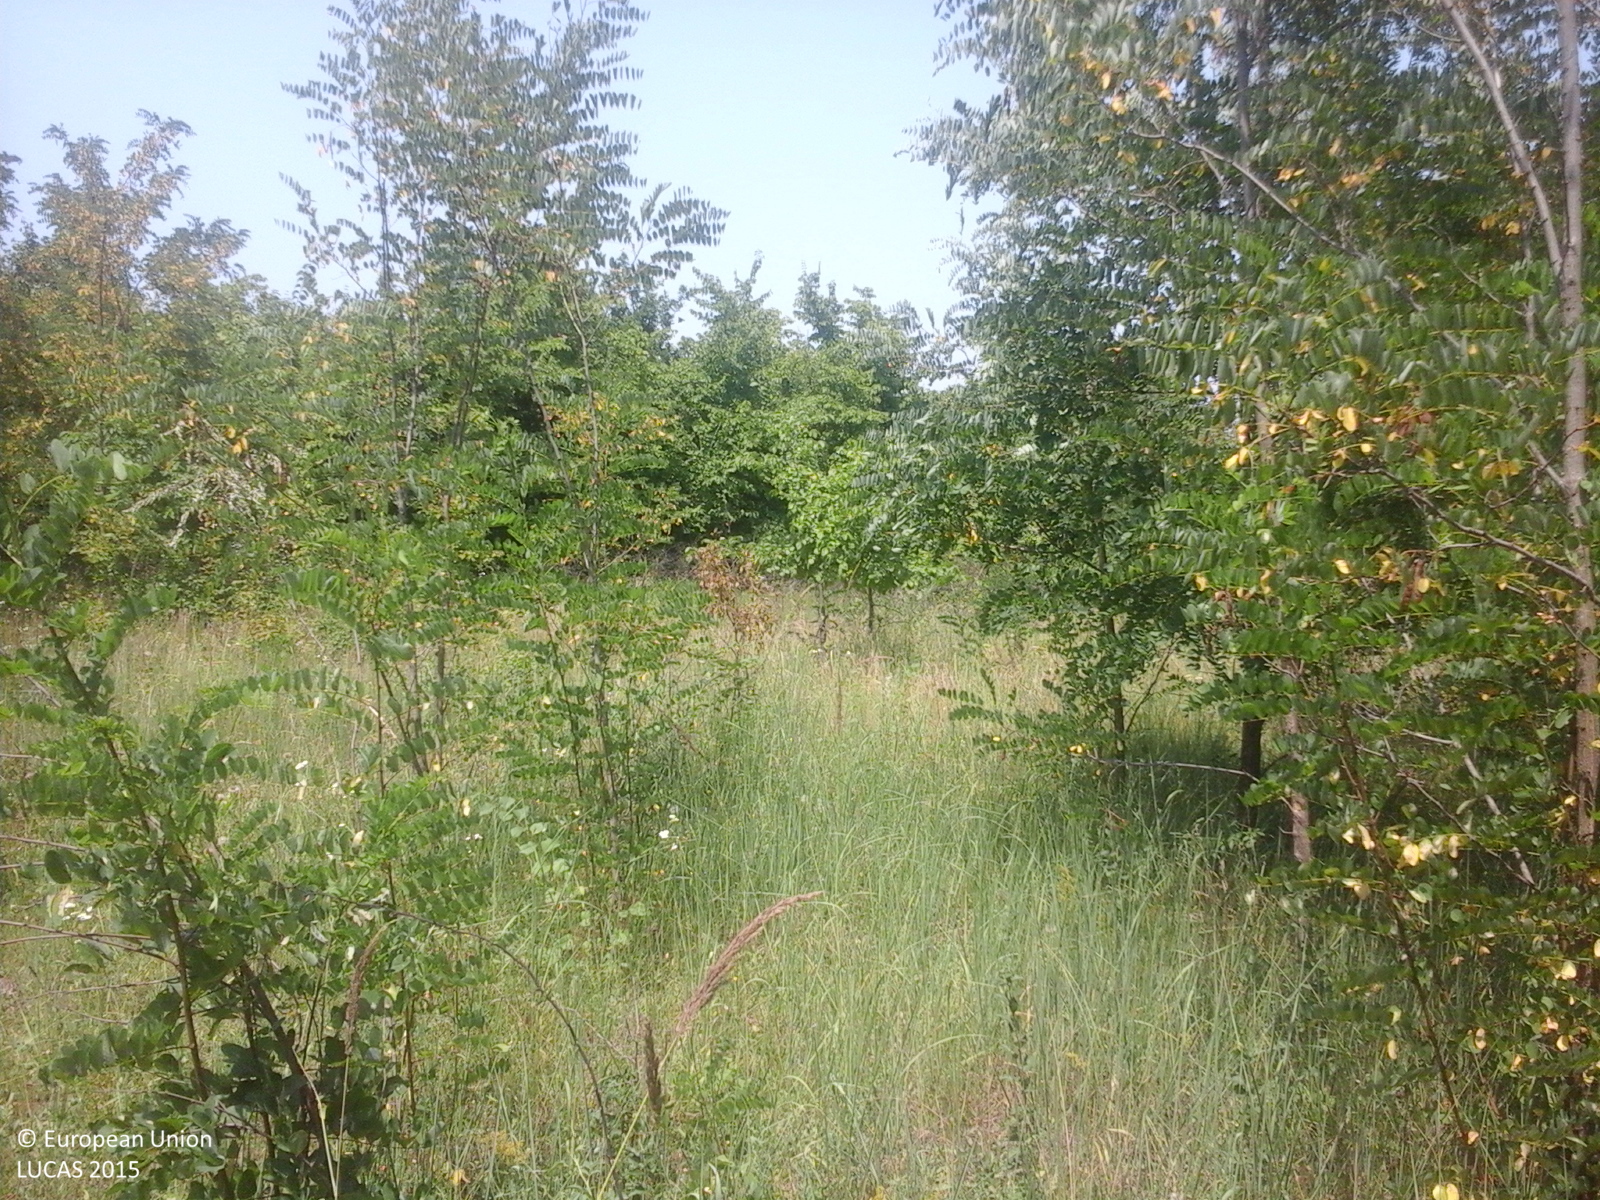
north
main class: Woodland
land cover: Broadleaved woodland
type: broadleaved evergreen forest
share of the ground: > 75 %
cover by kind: broadleaved forest trees 80 %, herbaceous plants 20 %
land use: Forestry
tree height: < 5 m
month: July
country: RO
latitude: 44.7490
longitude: 25.4135
